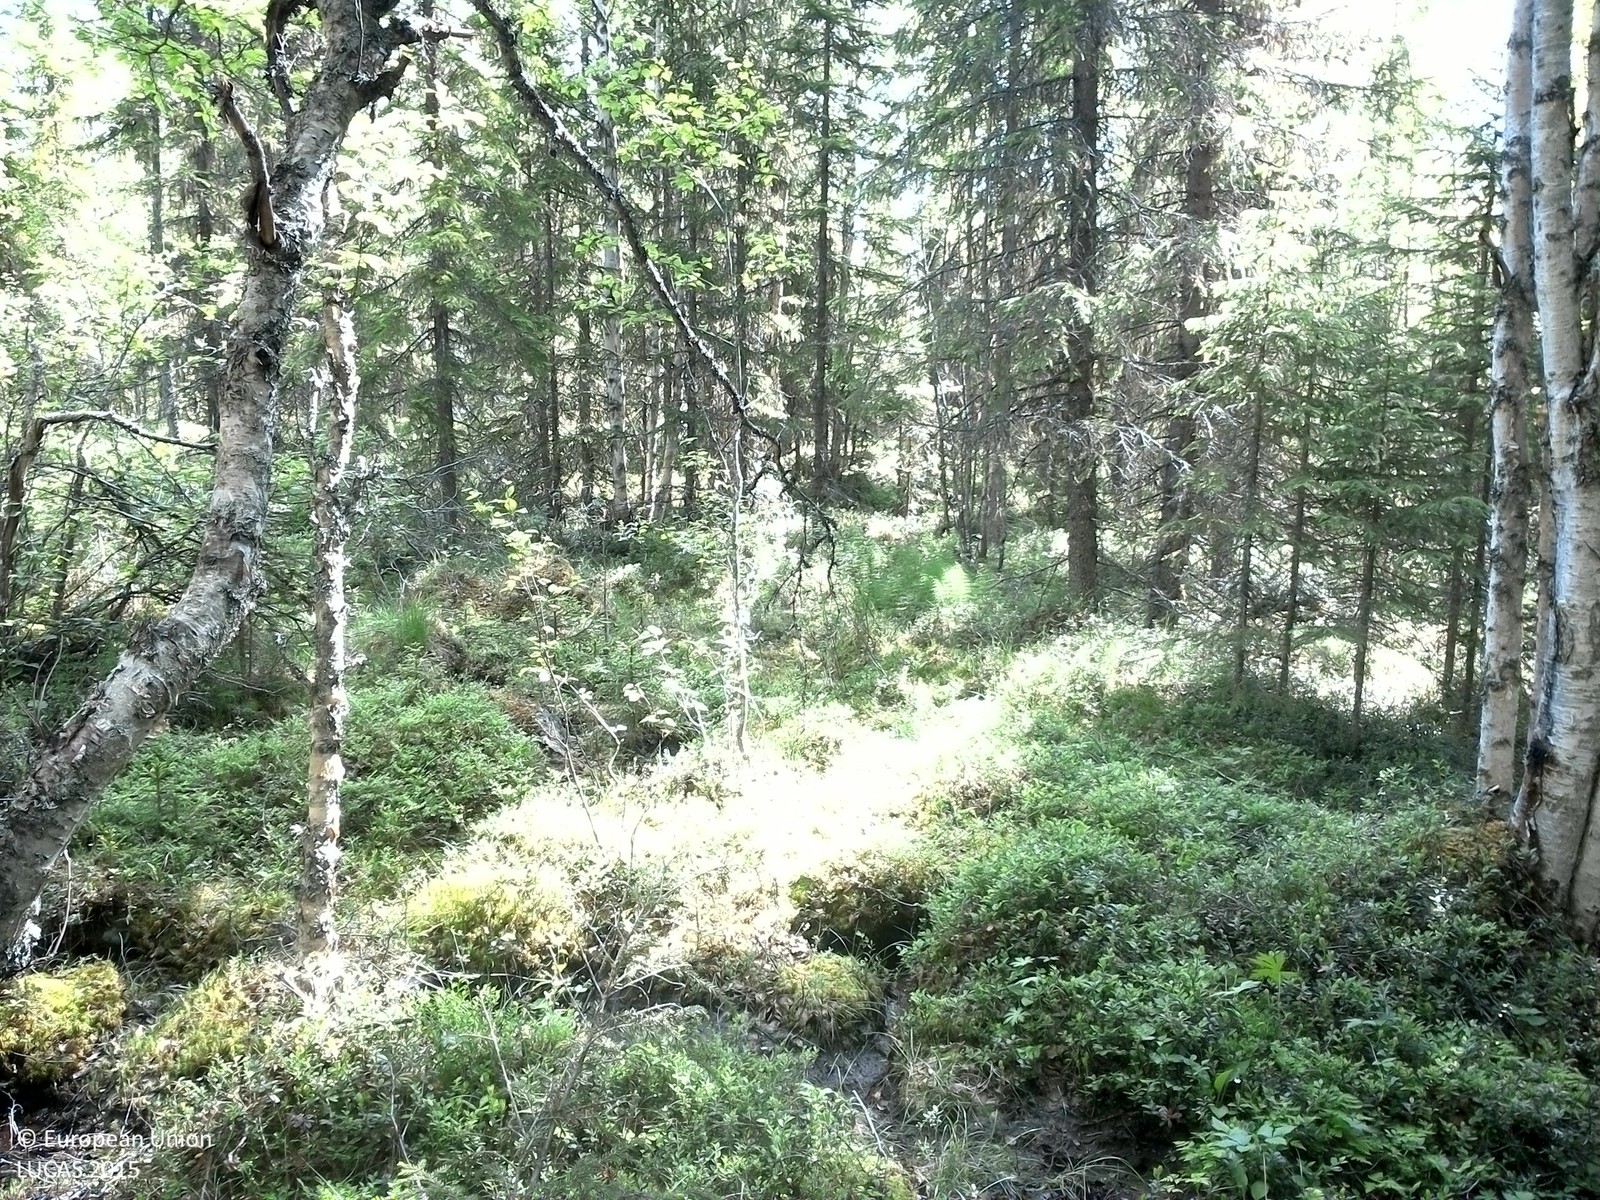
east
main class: Woodland
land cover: Spruce dominated mixed woodland
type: boreal forest
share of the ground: > 75 %
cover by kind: coniferous forest trees 55 %, broadleaved forest trees 20 %, shrubs 10 %, herbaceous plants 5 %, lichens and mosses 5 %, unconsolidated bare surface 5 %
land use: Forestry
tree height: > 5 m
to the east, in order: Spruce dominated mixed woodland; Spruce dominated coniferous woodland; Spruce dominated mixed woodland
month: July
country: SE
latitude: 64.2866
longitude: 16.8478
